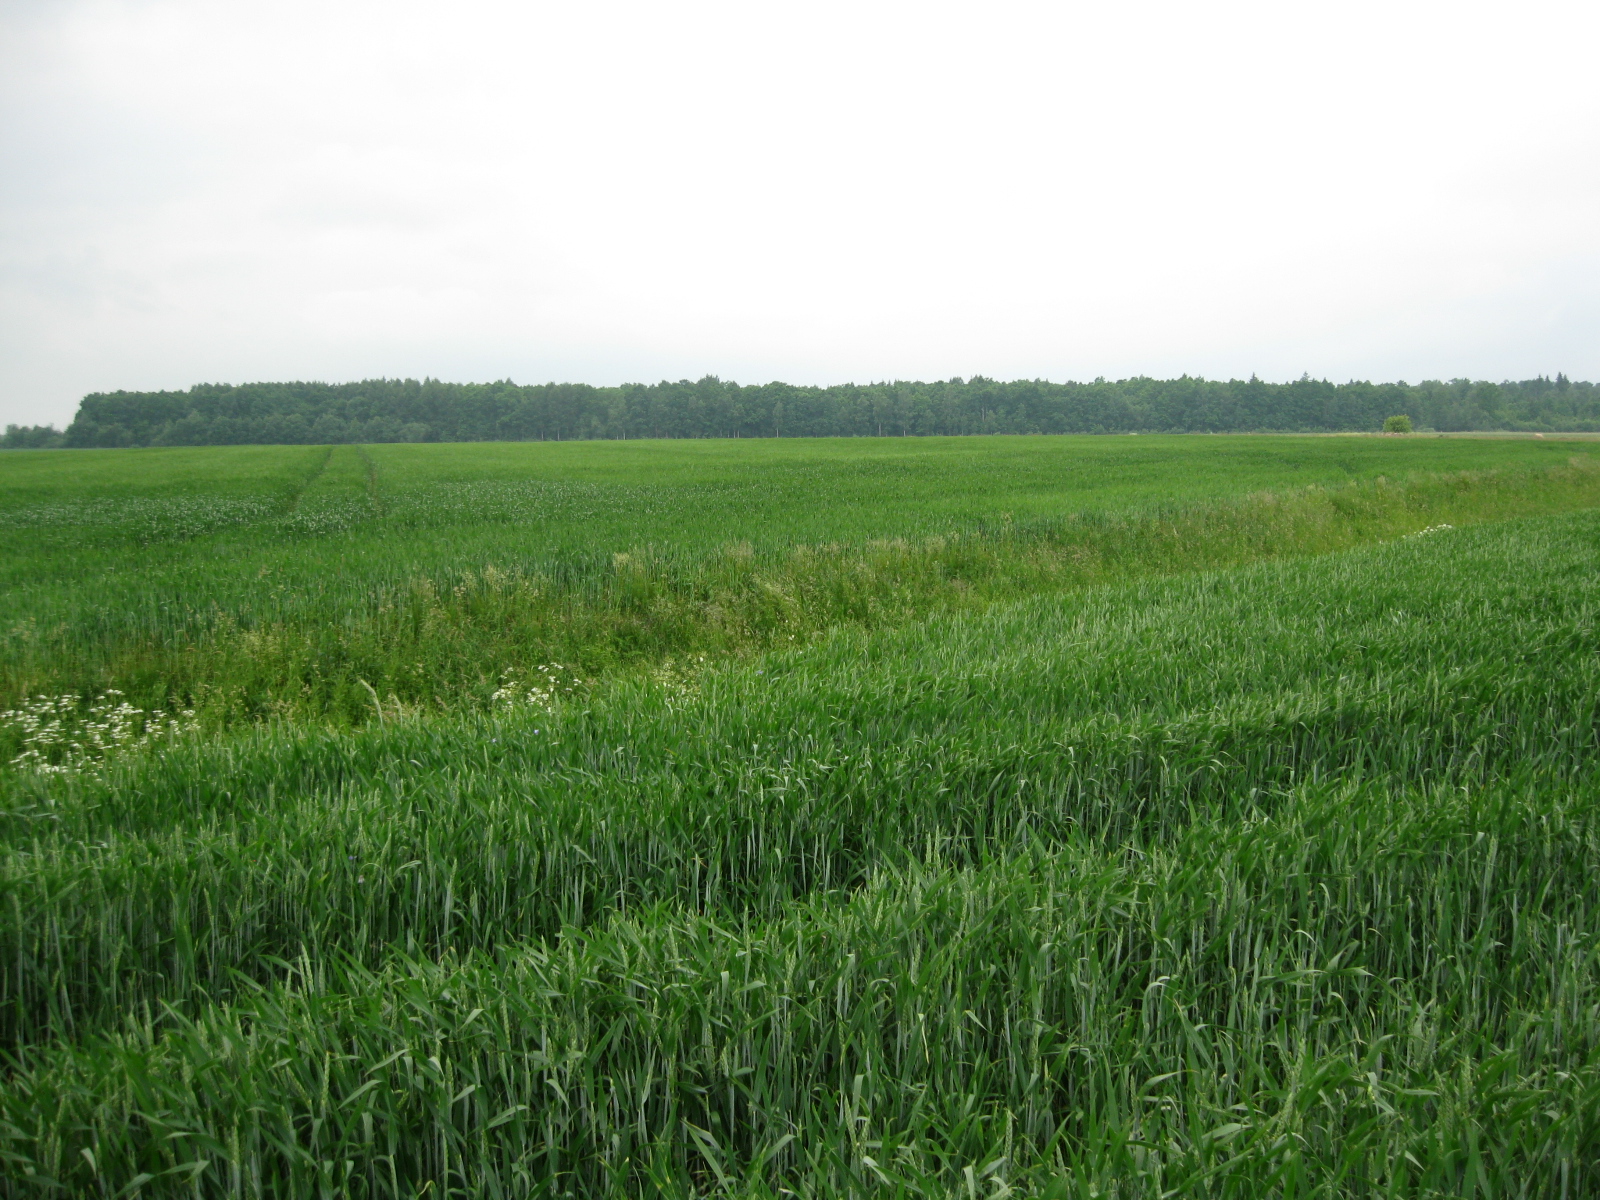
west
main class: Cropland
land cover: Common wheat
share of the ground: > 75 %
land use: Agriculture (excluding fallow land and kitchen gardens)
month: June
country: LT
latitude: 55.2862
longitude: 23.5108
